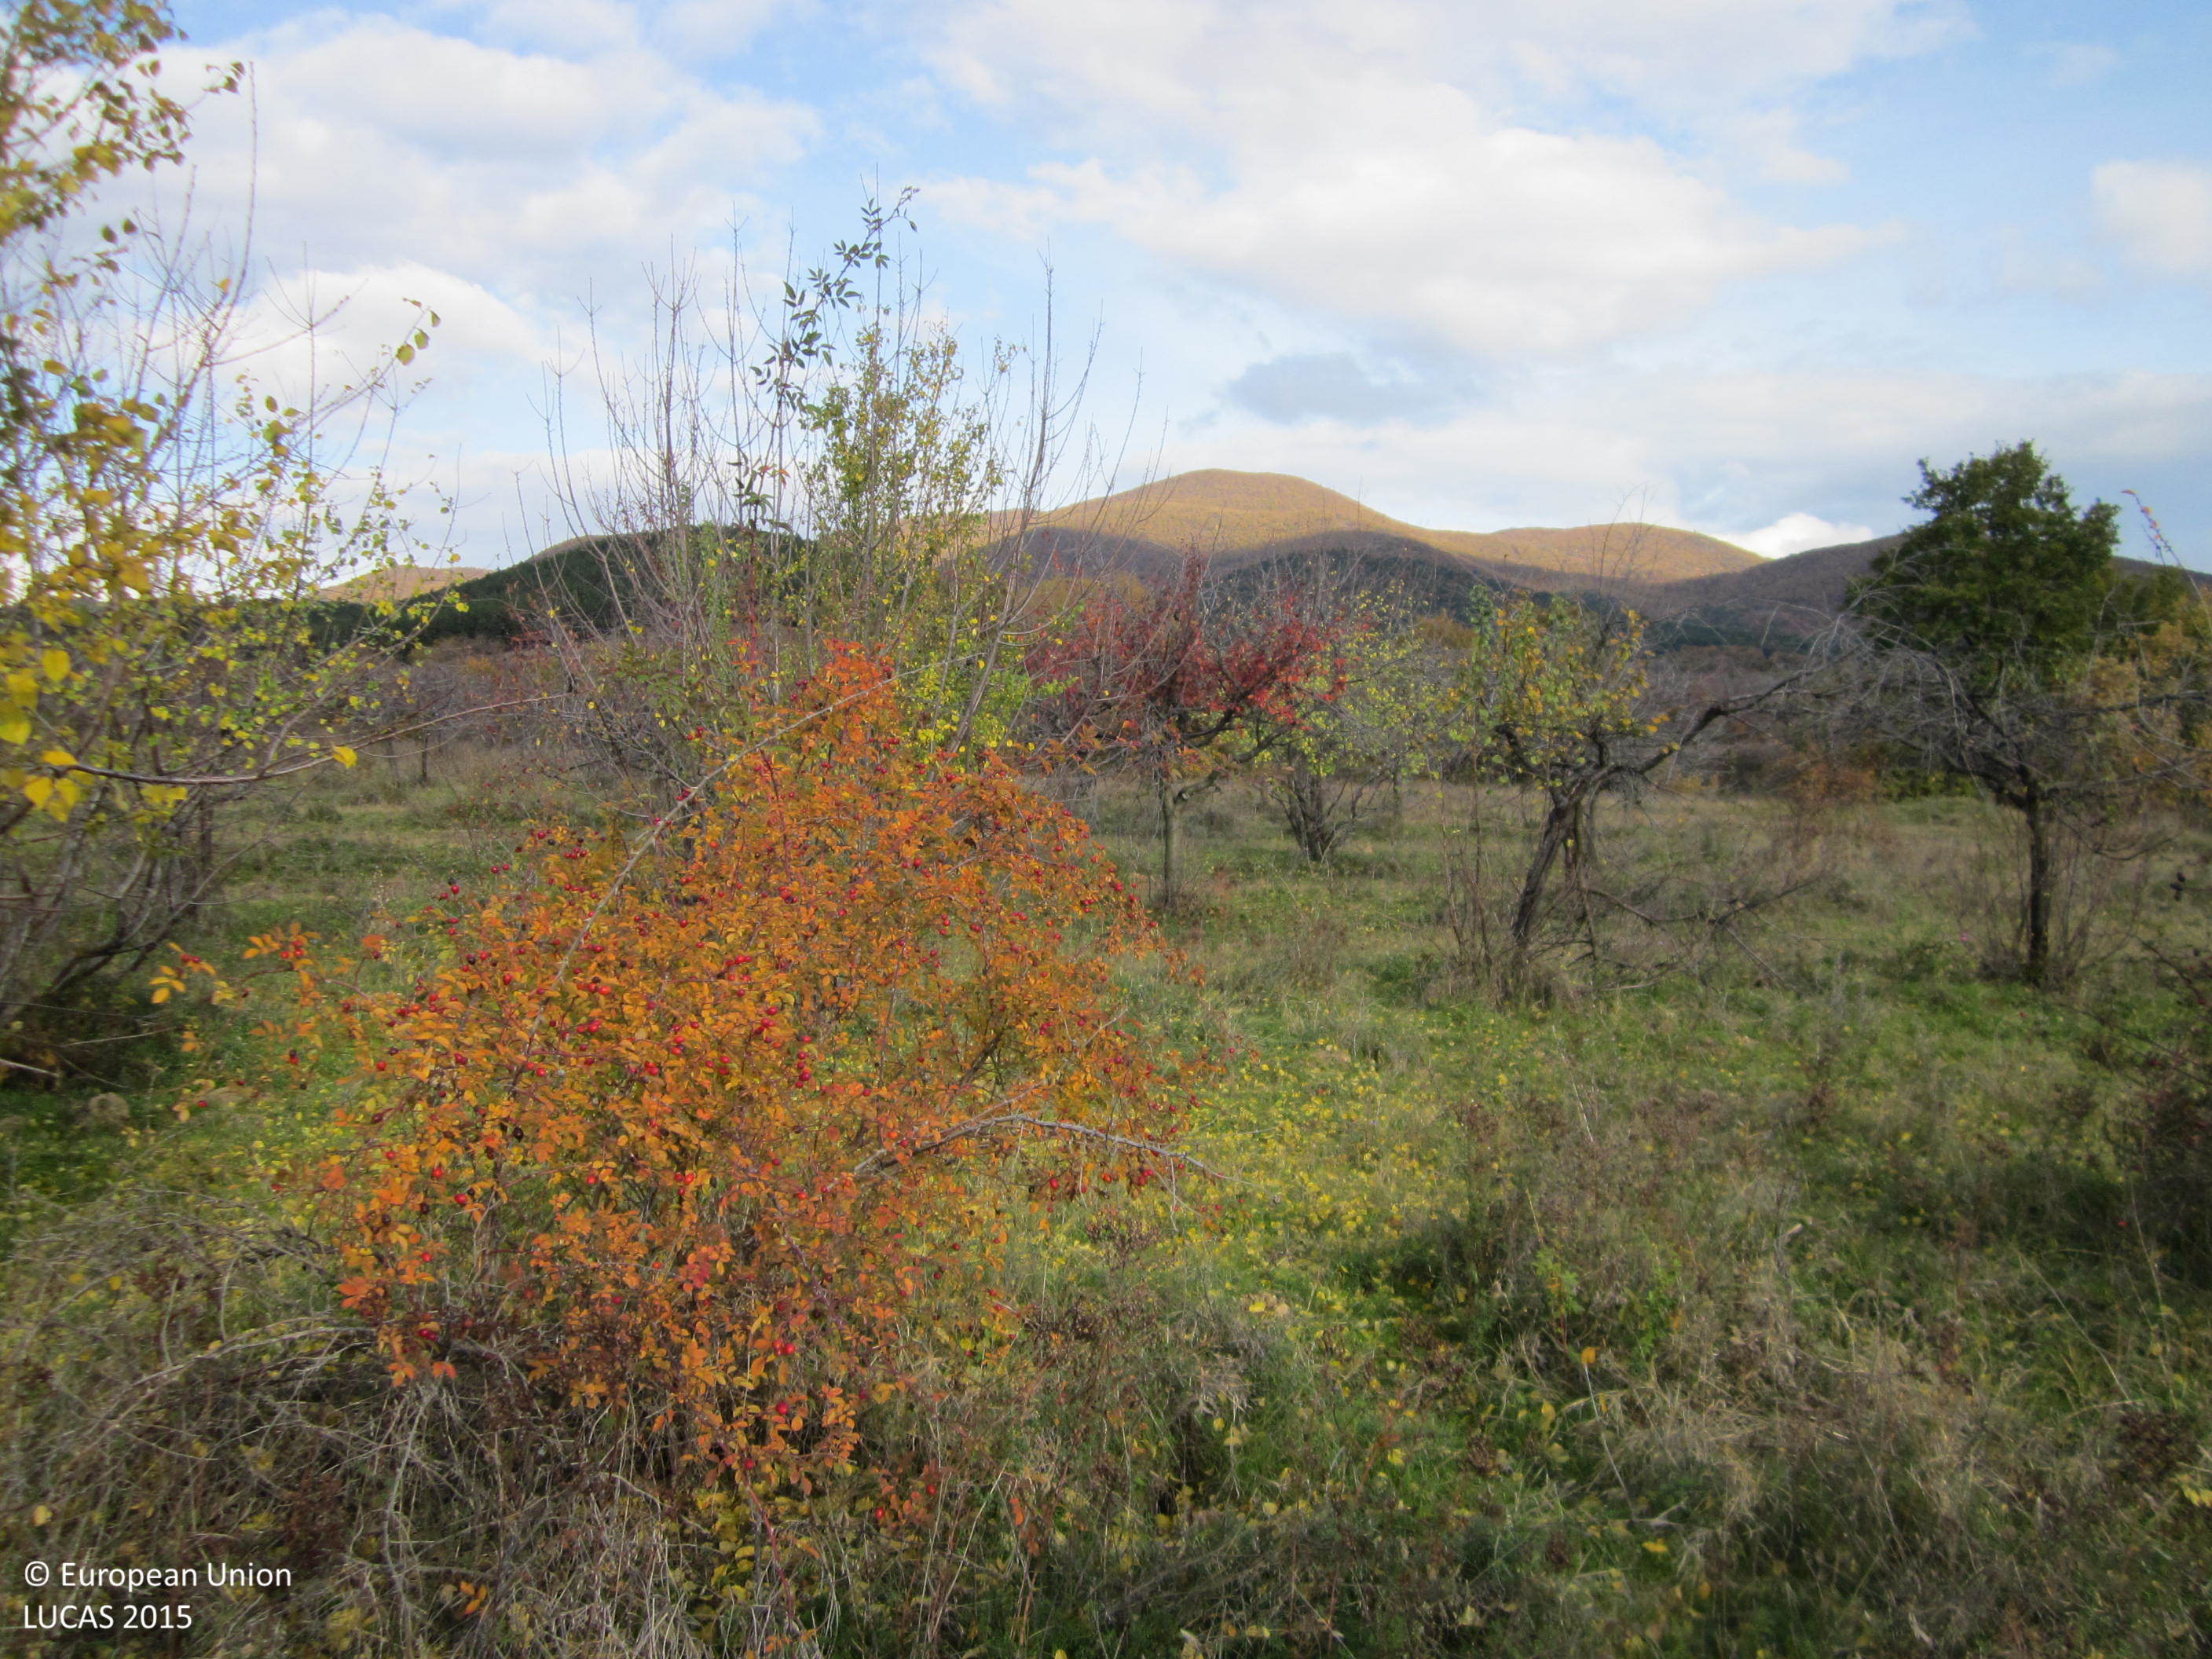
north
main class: Cropland
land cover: Cherry fruit
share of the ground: 50 - 75 %
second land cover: Grassland without tree/shrub cover
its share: > 75 %
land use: Agriculture (excluding fallow land and kitchen gardens)
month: November
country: BG
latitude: 42.5276
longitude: 24.7001
